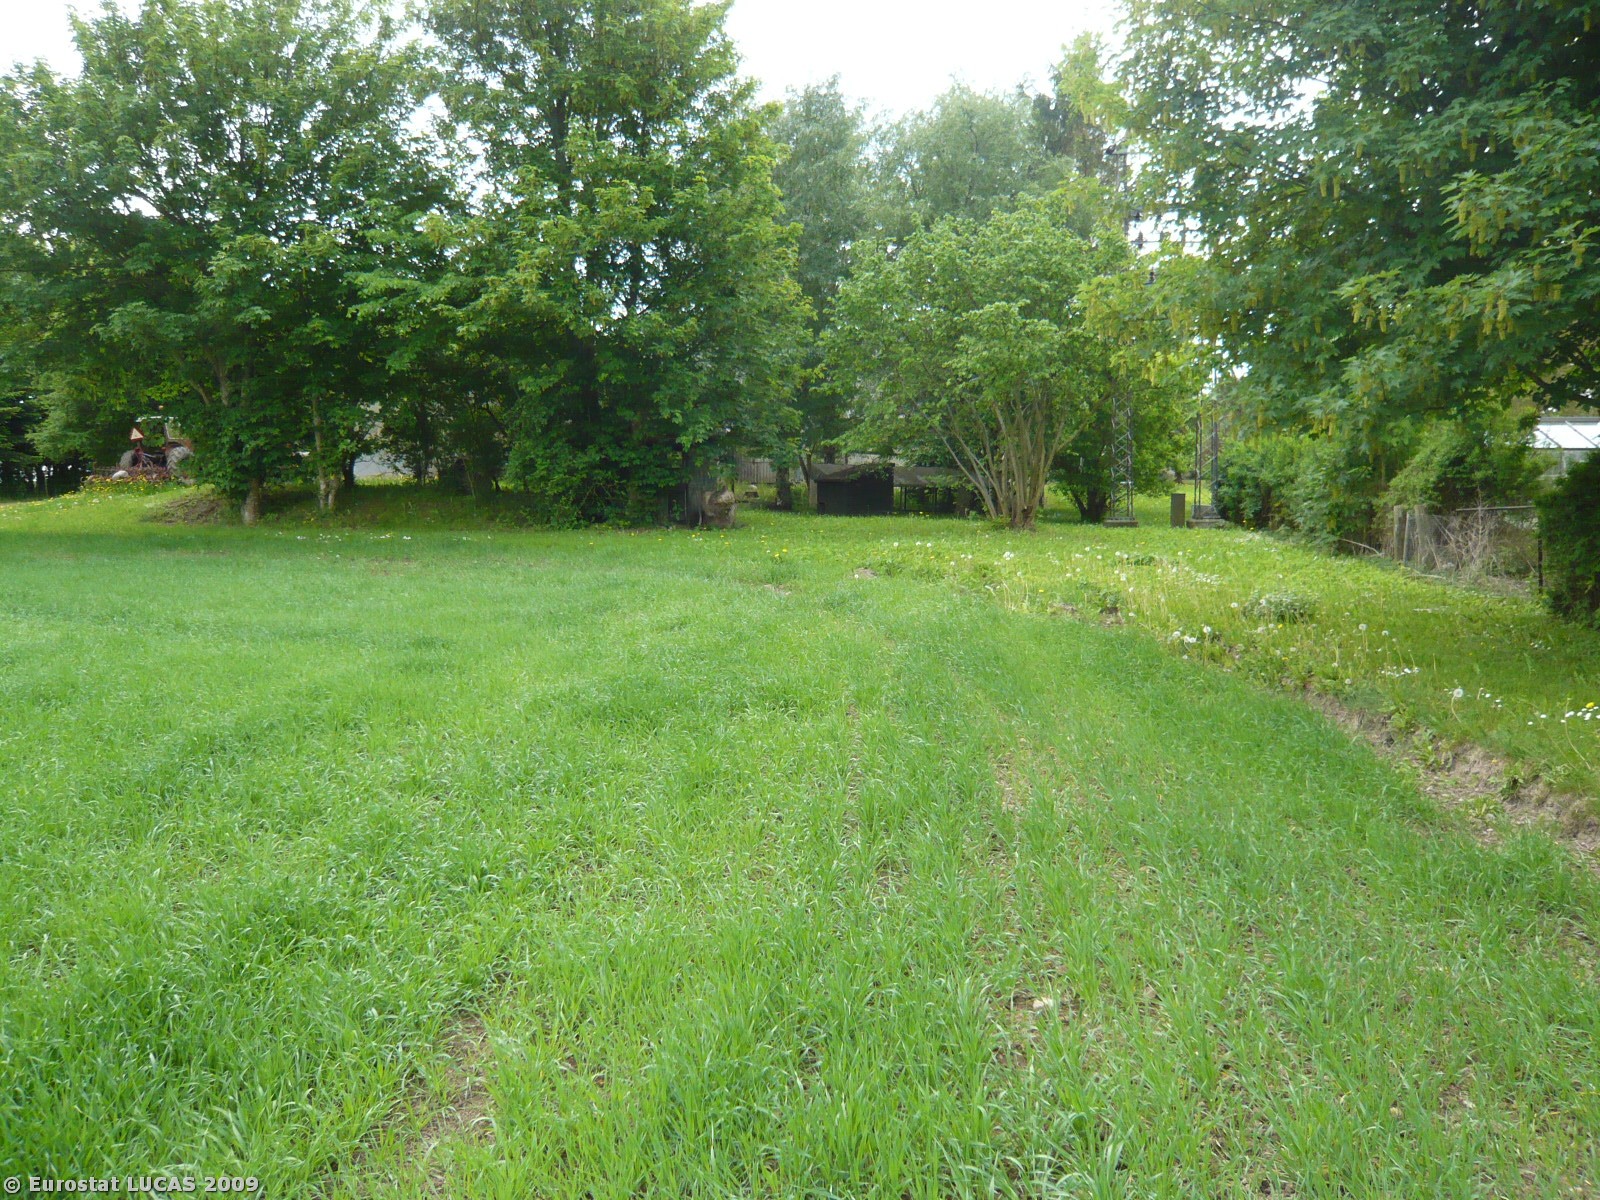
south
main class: Cropland
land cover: Barley
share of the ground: > 75 %
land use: Agriculture (excluding fallow land and kitchen gardens)
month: May
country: DK
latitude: 55.3465
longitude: 11.9066
